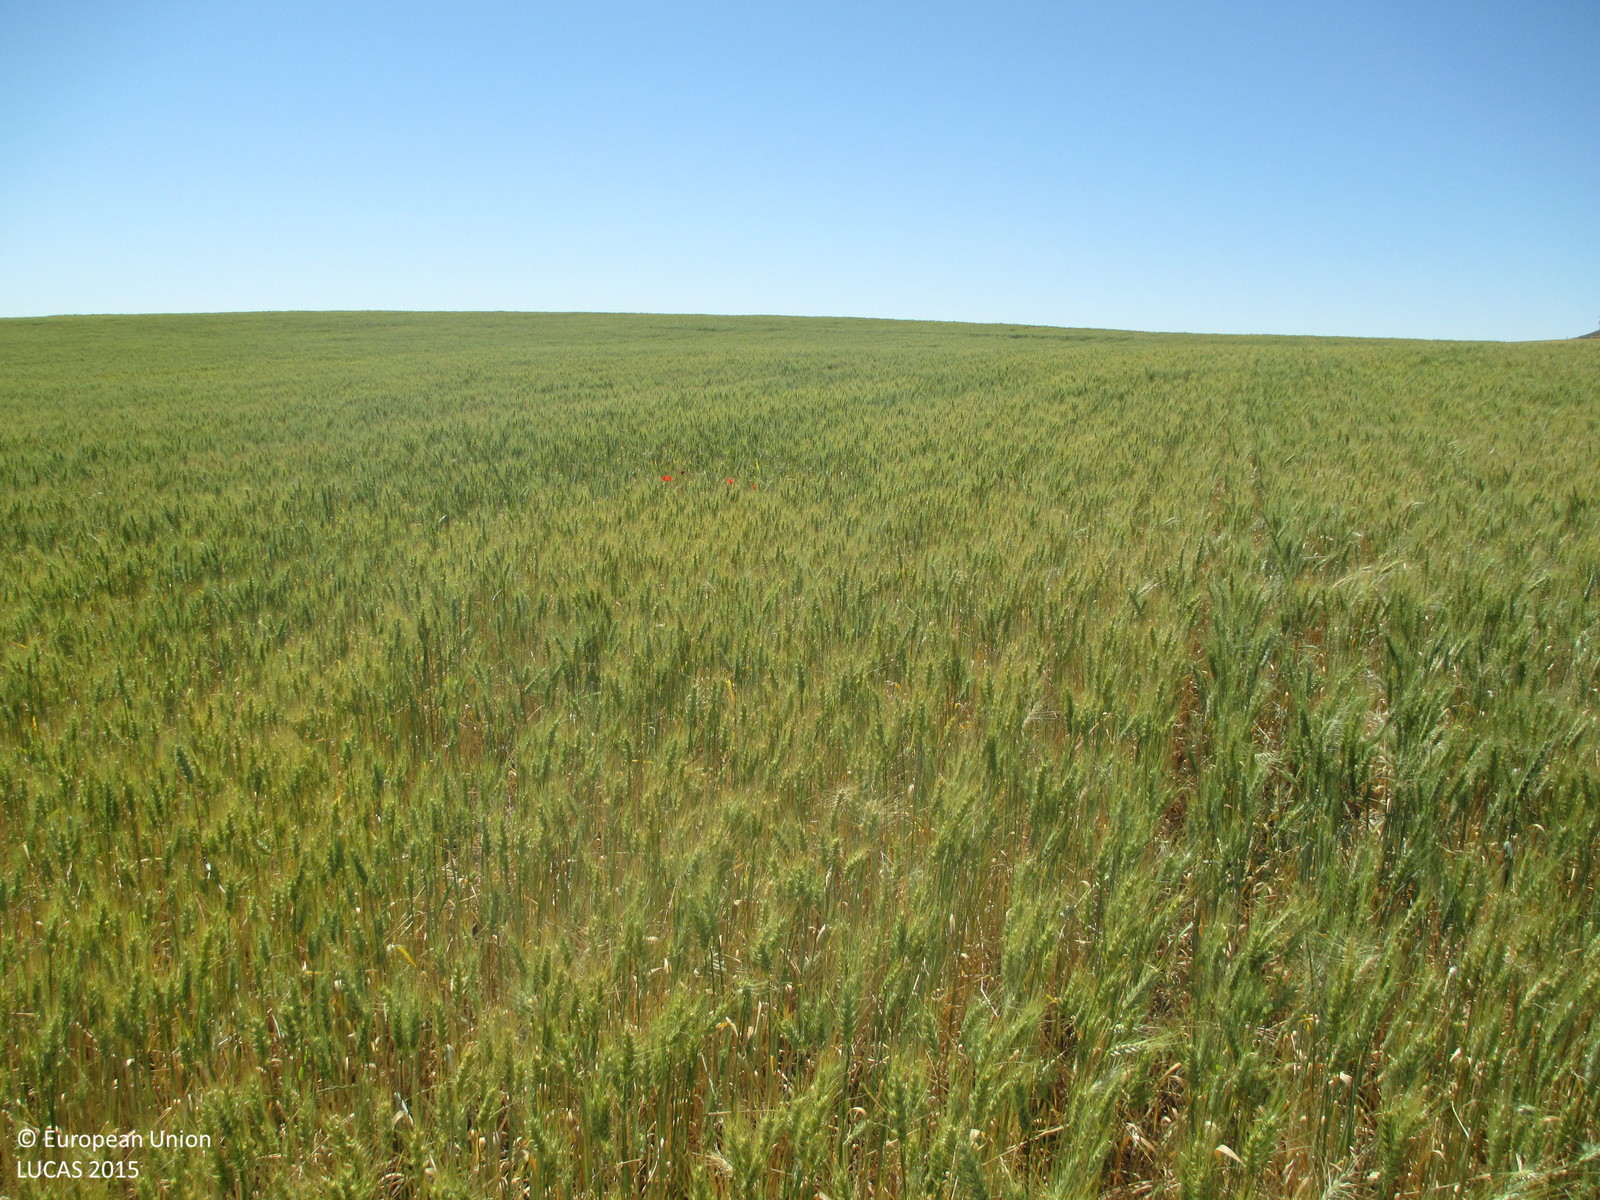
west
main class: Cropland
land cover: Durum wheat
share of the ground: > 75 %
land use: Agriculture (excluding fallow land and kitchen gardens)
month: May
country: ES
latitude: 42.0618
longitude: -0.2321
